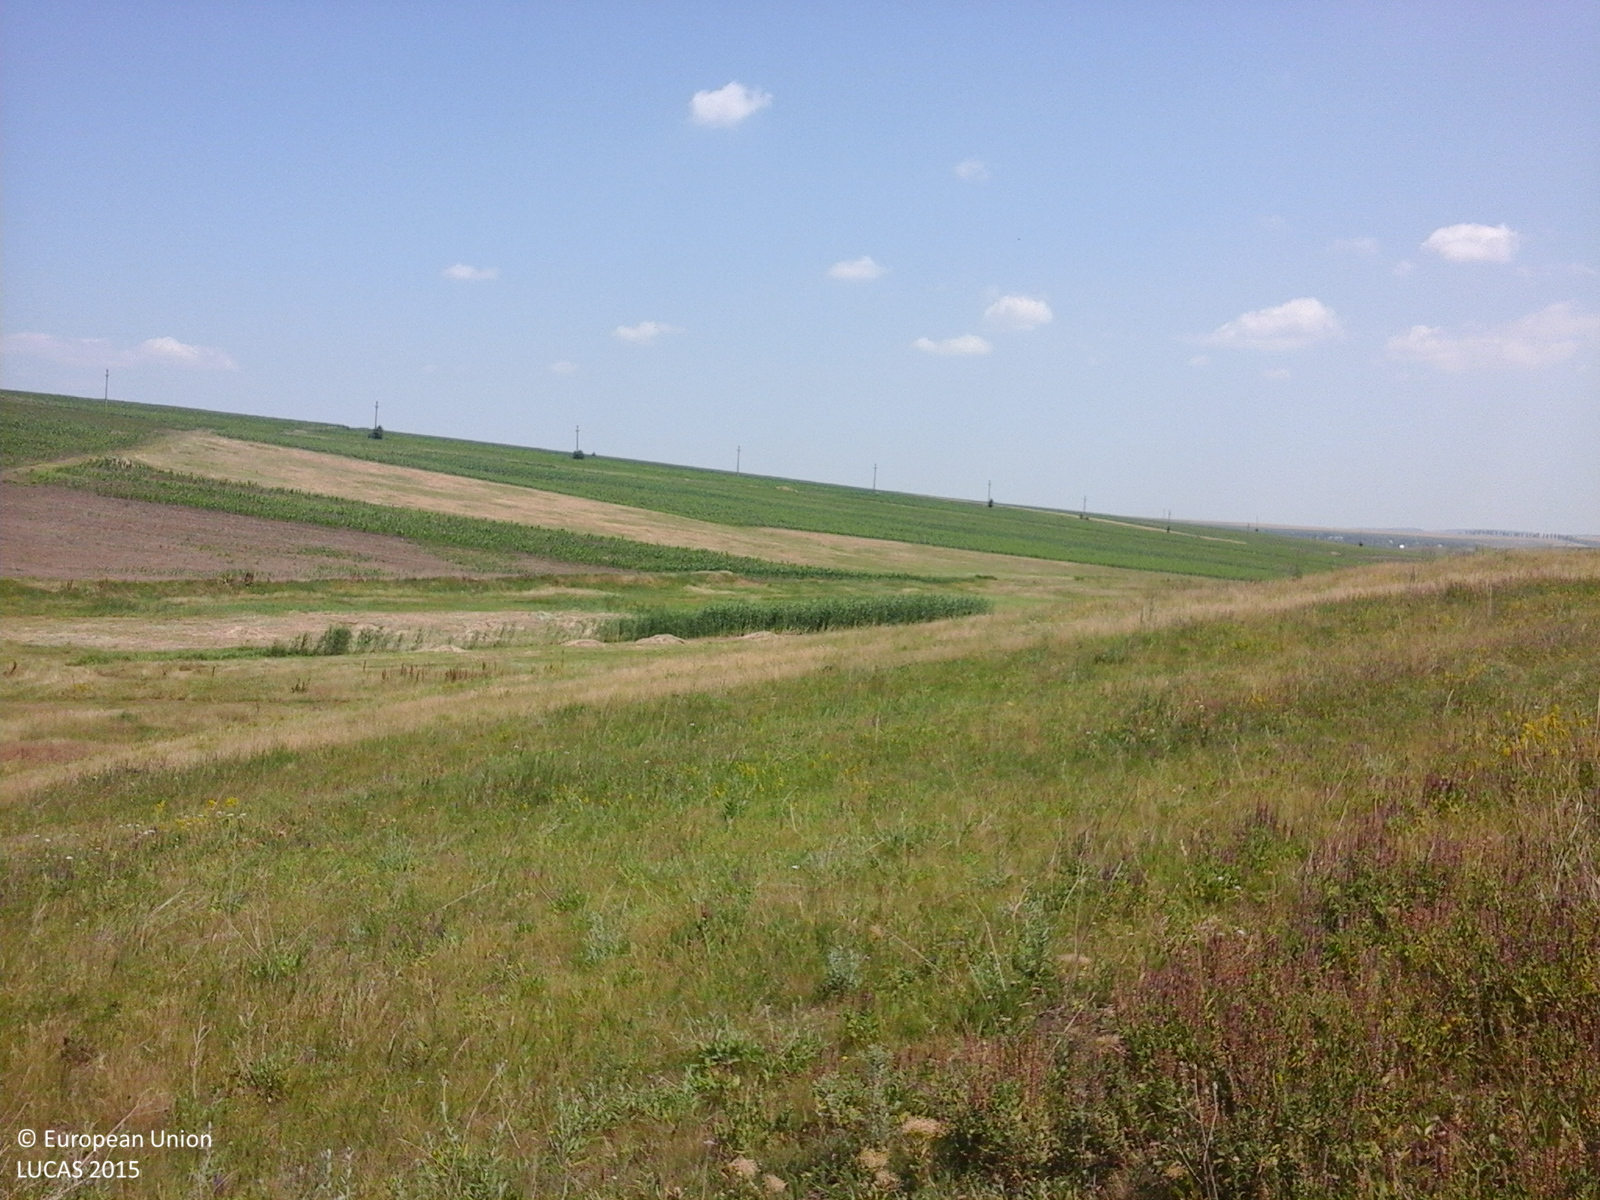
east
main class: Grassland
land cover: Grassland without tree/shrub cover
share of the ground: > 75 %
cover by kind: herbaceous plants 100 %
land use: Agriculture (excluding fallow land and kitchen gardens)
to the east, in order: Grassland without tree/shrub cover; Ditches and canals; Grassland without tree/shrub cover; Tracks; Grassland without tree/shrub cover
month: June
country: RO
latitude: 47.4461
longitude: 27.2031
